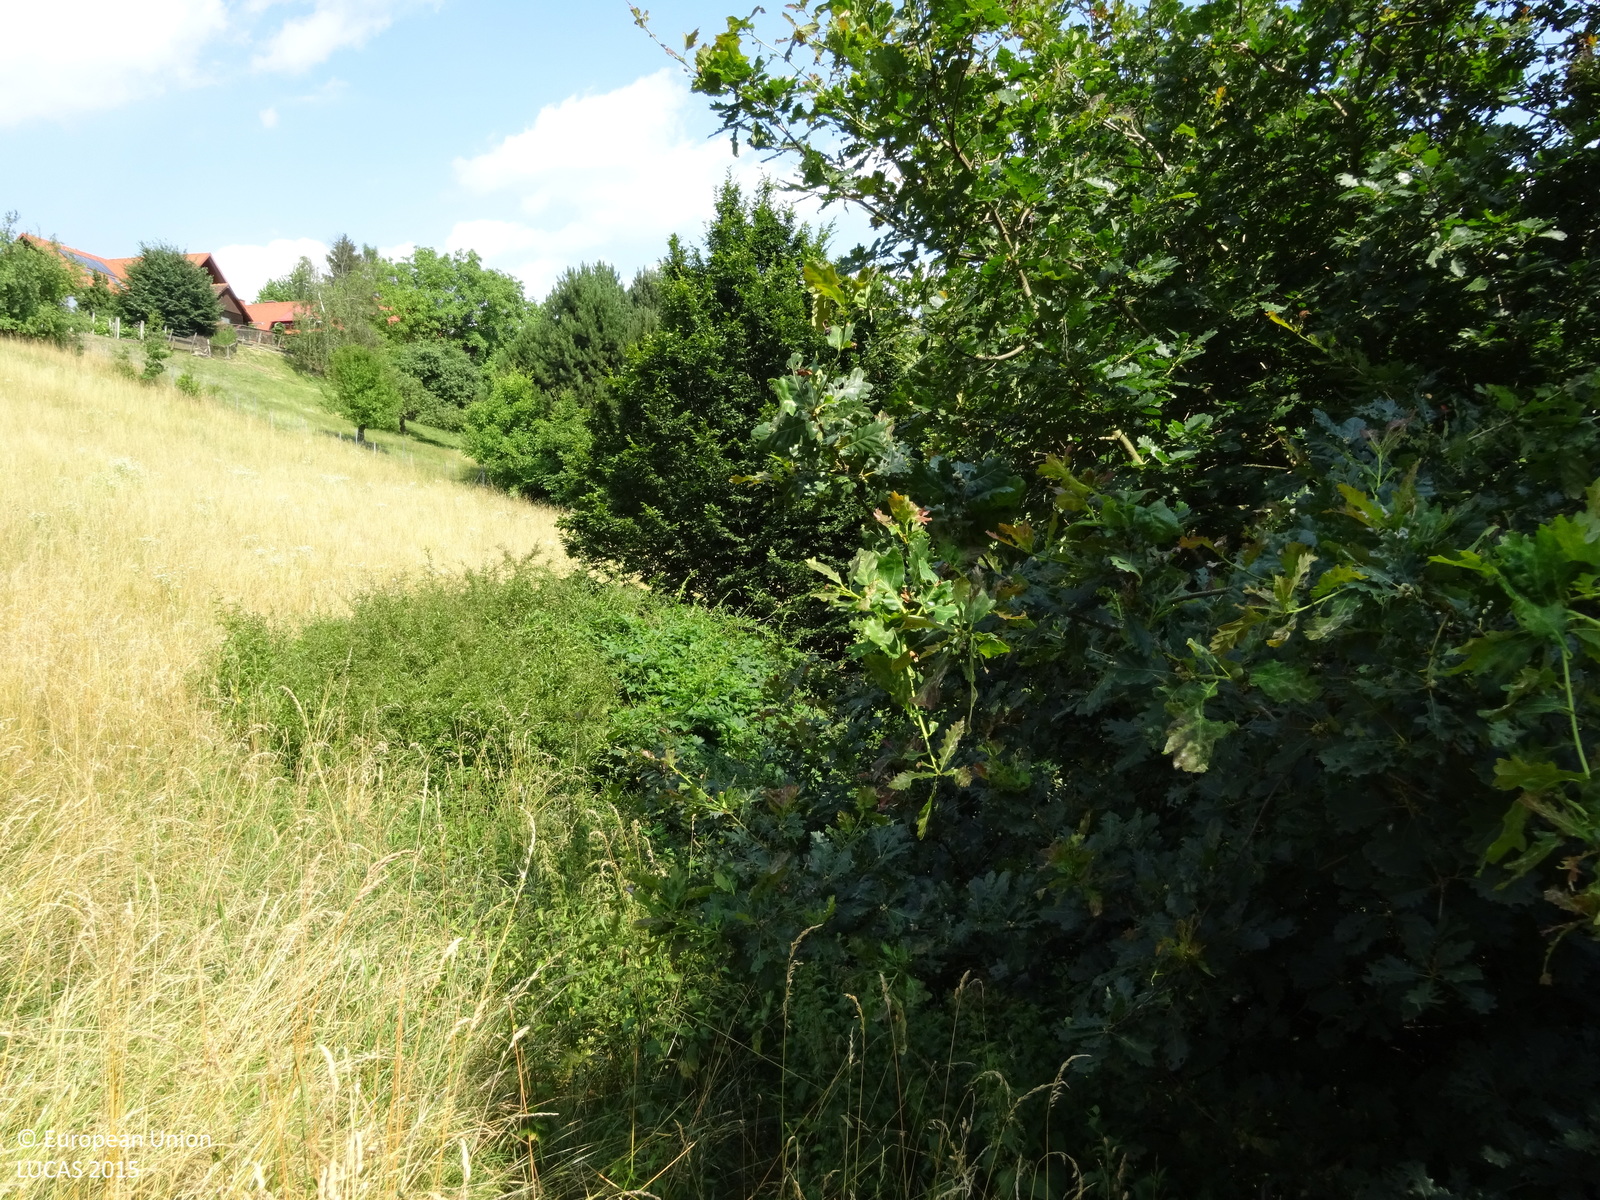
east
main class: Grassland
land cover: Grassland without tree/shrub cover
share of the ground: > 75 %
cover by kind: herbaceous plants 100 %
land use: Agriculture (excluding fallow land and kitchen gardens)
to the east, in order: Grassland without tree/shrub cover; Fences; Grassland with sparse tree/shrub cover; Artificial constructions in urban areas; Grassland with sparse tree/shrub cover; Paved roads, cycling and walking lanes; Grass margins; Electric lines; Other fibre and oleaginous crops
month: July
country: AT
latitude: 46.8856
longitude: 16.0243
